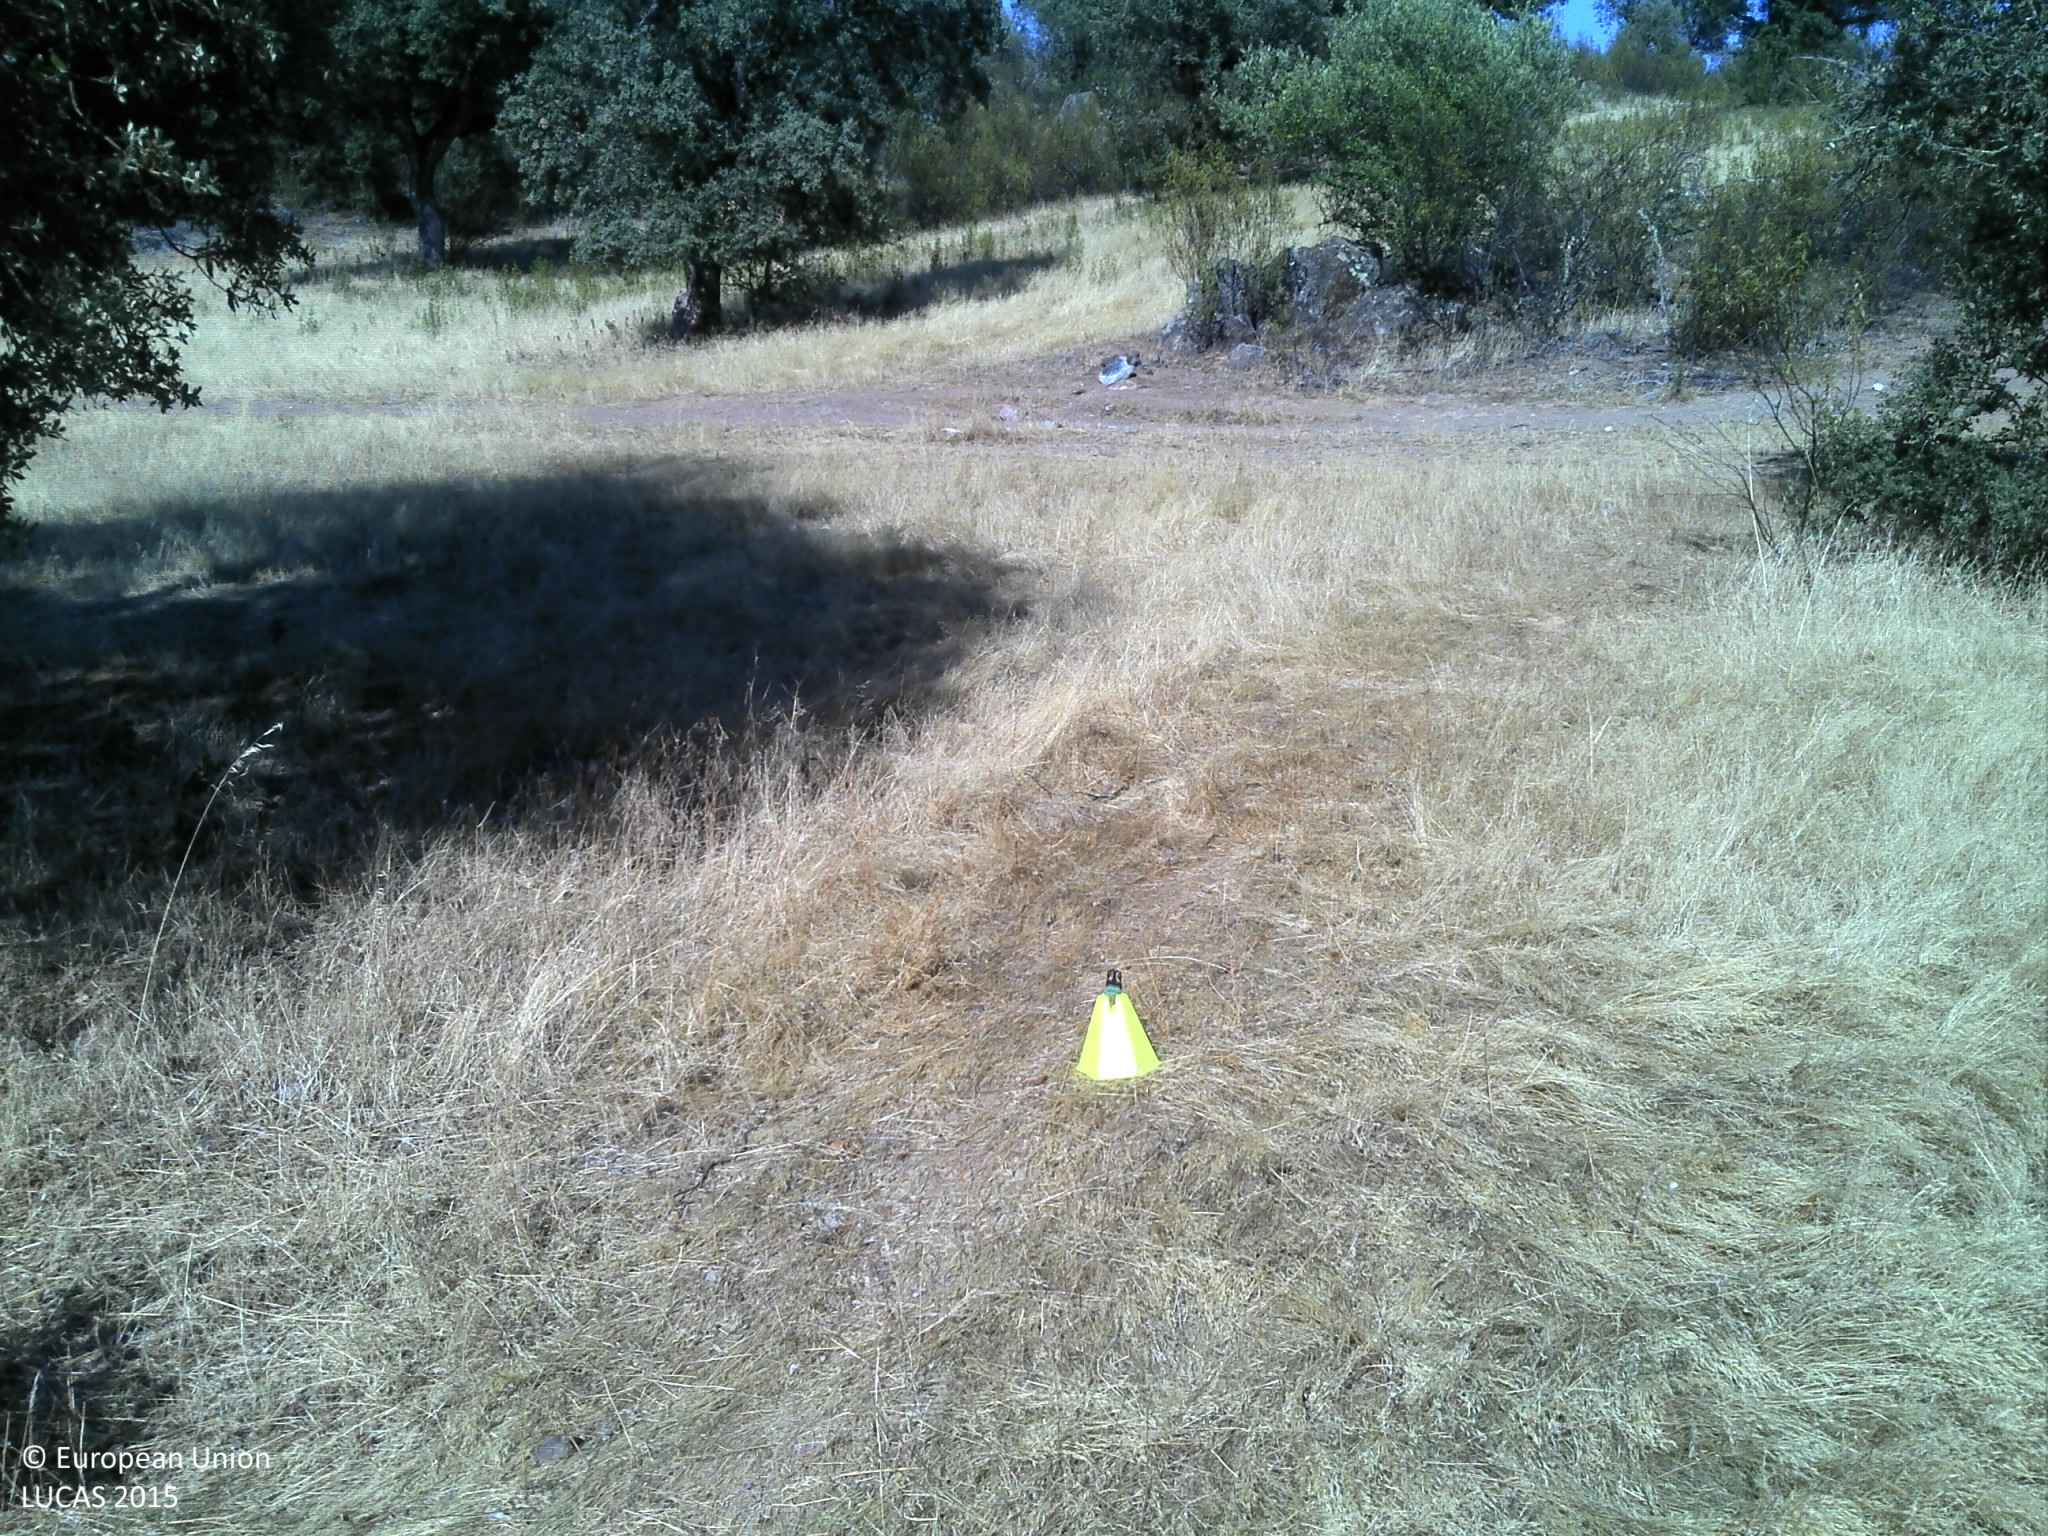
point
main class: Woodland
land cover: Broadleaved woodland
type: broadleaved evergreen forest
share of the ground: 10 - 25 %
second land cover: Grassland without tree/shrub cover
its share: 50 - 75 %
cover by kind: herbaceous plants 60 %, unconsolidated bare surface 25 %, broadleaved forest trees 10 %, shrubs 5 %
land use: Forestry
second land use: Agriculture (excluding fallow land and kitchen gardens)
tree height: > 5 m
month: July
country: PT
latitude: 38.5833
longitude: -7.3260
